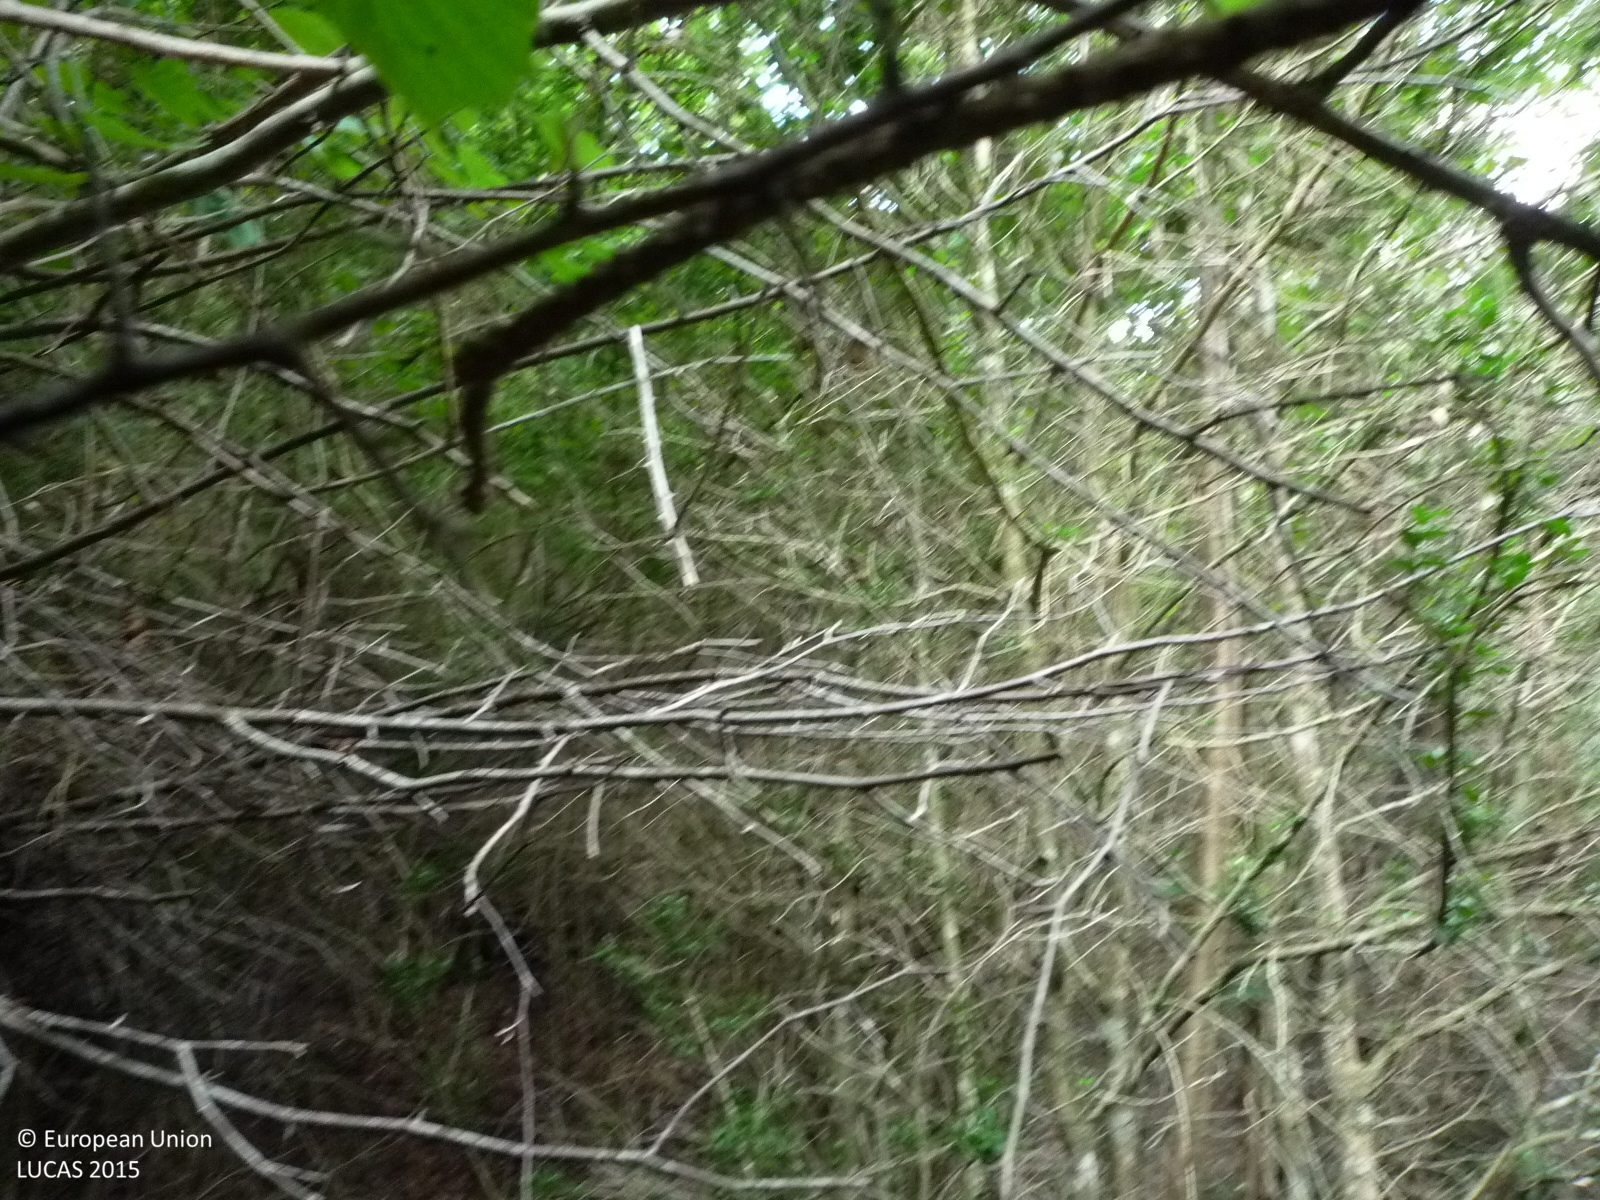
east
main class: Woodland
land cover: Pine dominated mixed woodland
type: coniferous forest of the mediterranean region
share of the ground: > 75 %
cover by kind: coniferous forest trees 55 %, broadleaved forest trees 45 %
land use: Semi-natural and natural areas not in use
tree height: > 5 m
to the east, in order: Pine dominated mixed woodland; Tracks; Pine dominated mixed woodland; Tracks; Pine dominated mixed woodland; Tracks; Pine dominated mixed woodland
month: July
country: ES
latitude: 42.1843
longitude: 2.1310
